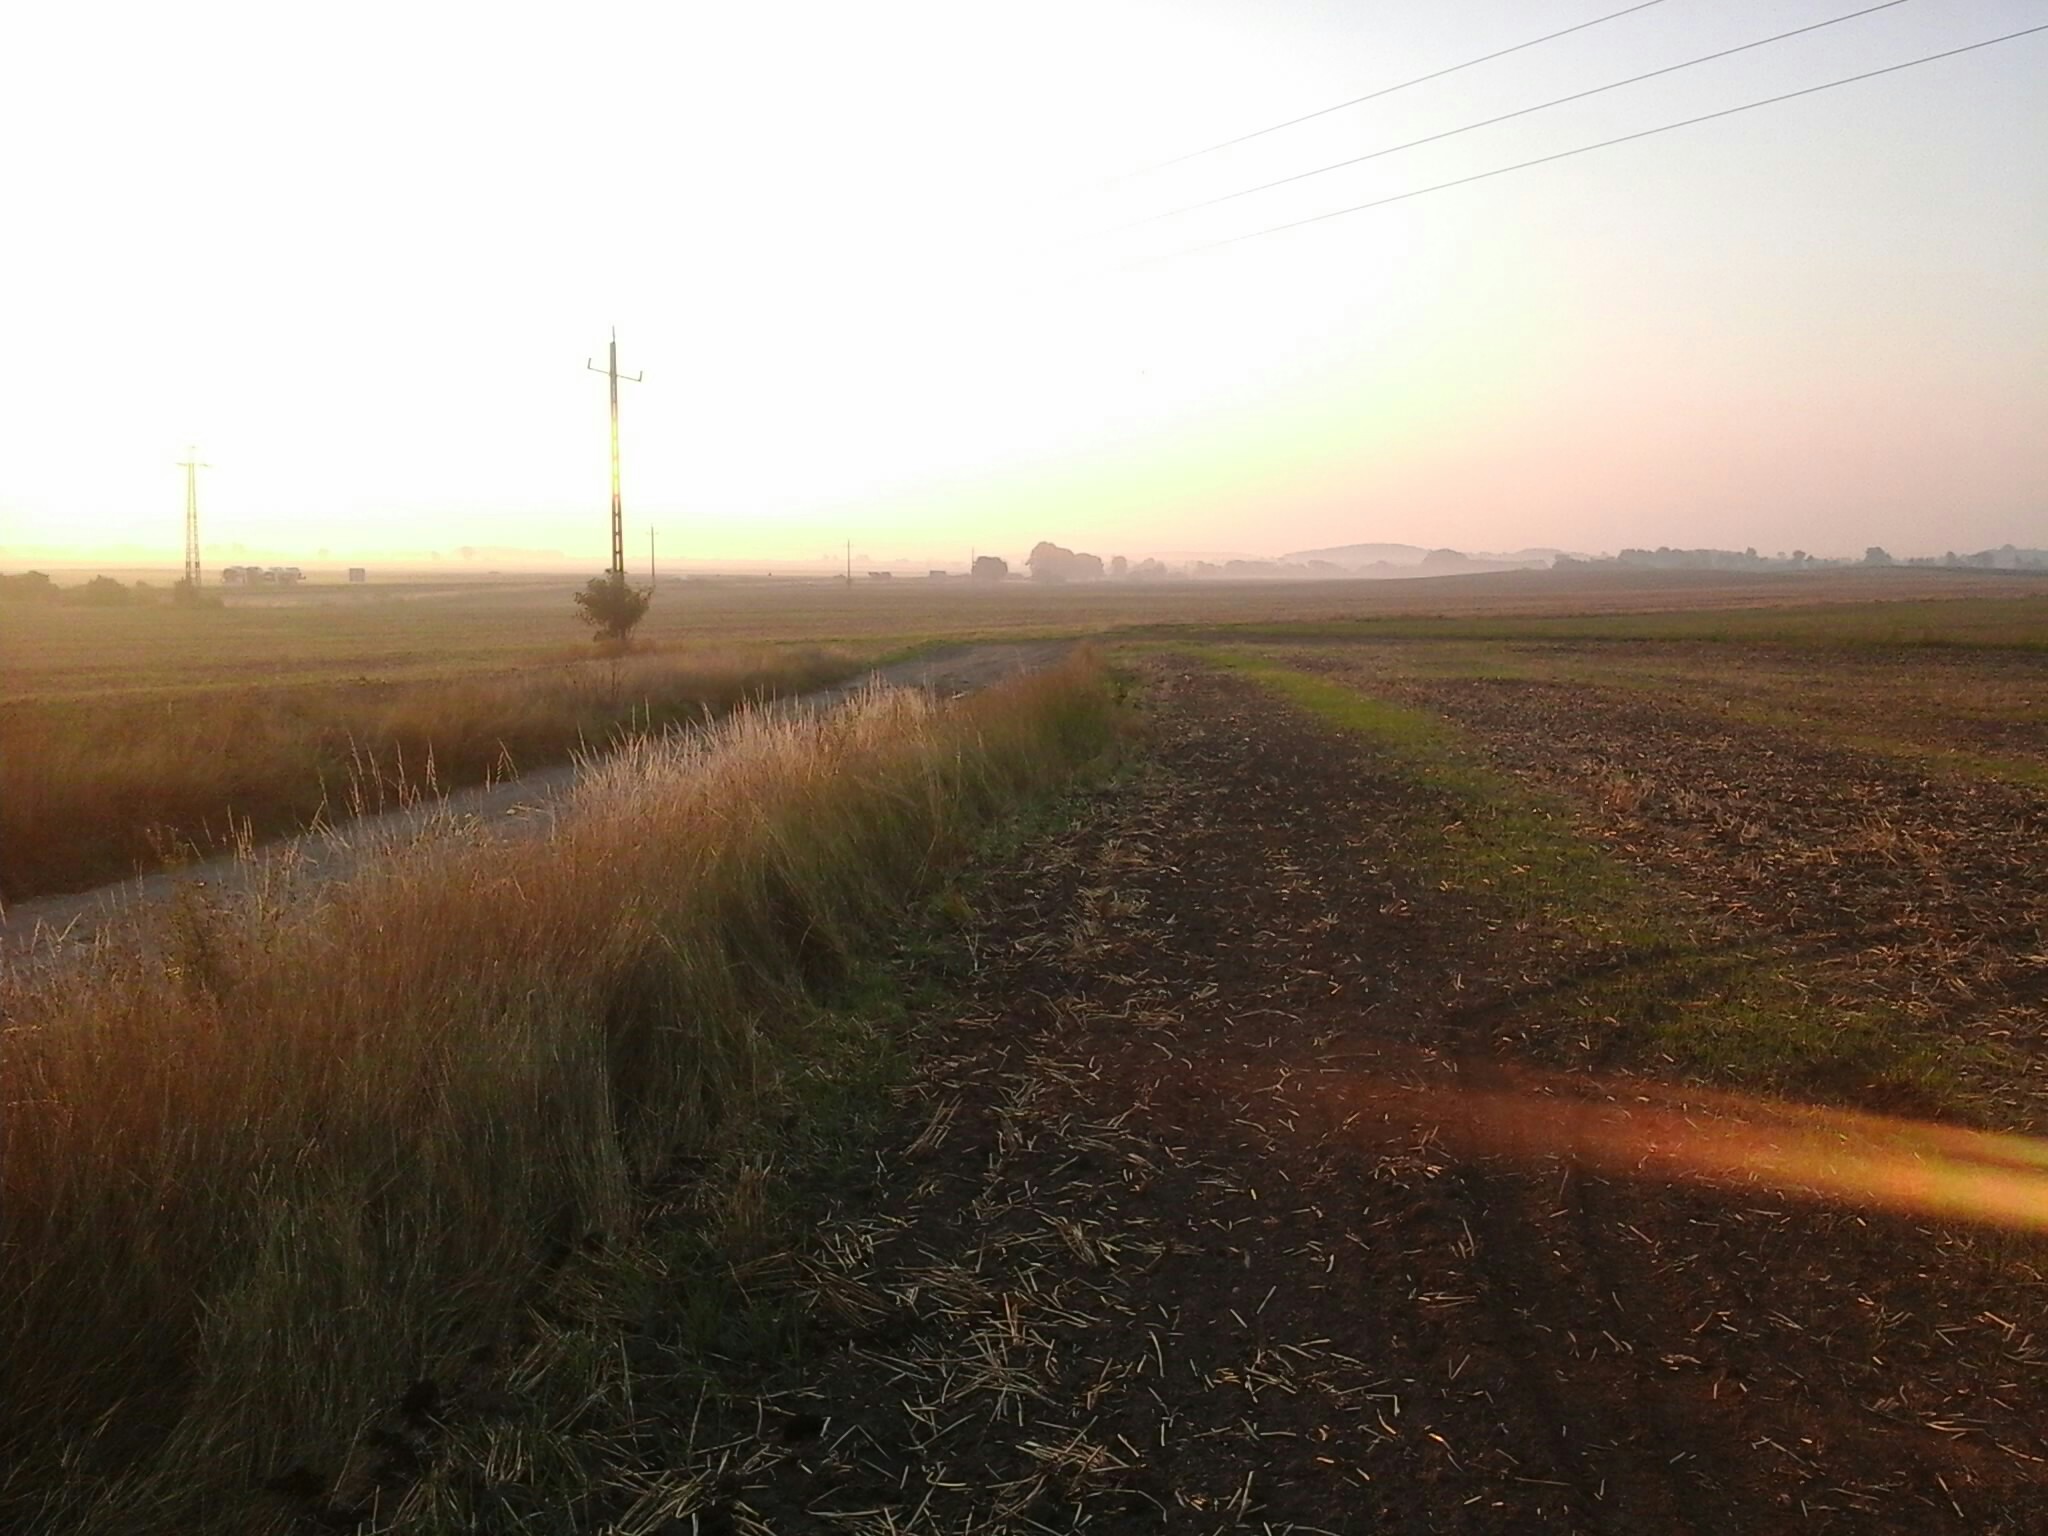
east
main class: Cropland
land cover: Common wheat
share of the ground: < 10 %
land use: Agriculture (excluding fallow land and kitchen gardens)
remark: Harvested field
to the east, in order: Common wheat; Grass margins; Tracks; Grass margins; Common wheat; Electric lines; Common wheat
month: August
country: HU
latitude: 47.6703
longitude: 18.1228
